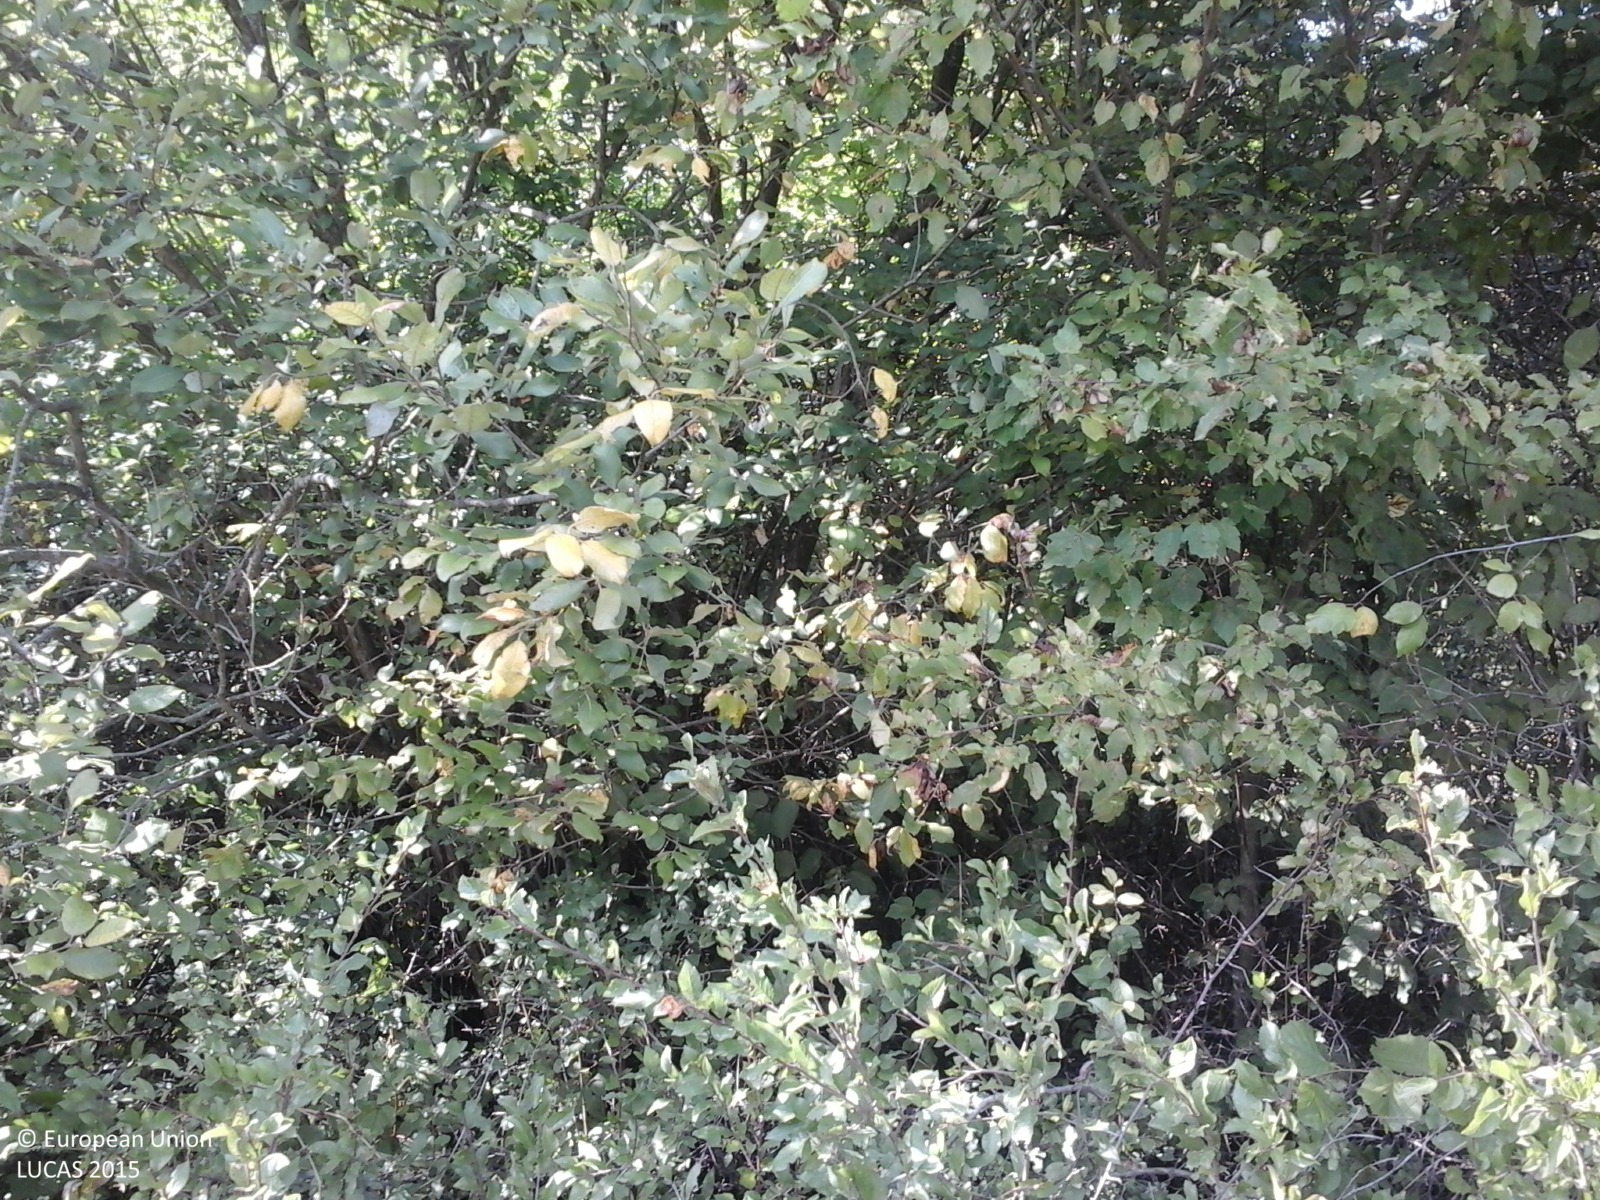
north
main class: Shrubland
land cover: Shrubland with sparse tree cover
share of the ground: > 75 %
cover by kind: shrubs 95 %, broadleaved forest trees 5 %
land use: Fallow land
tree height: > 5 m
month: September
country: RO
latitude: 47.3669
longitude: 23.0825
